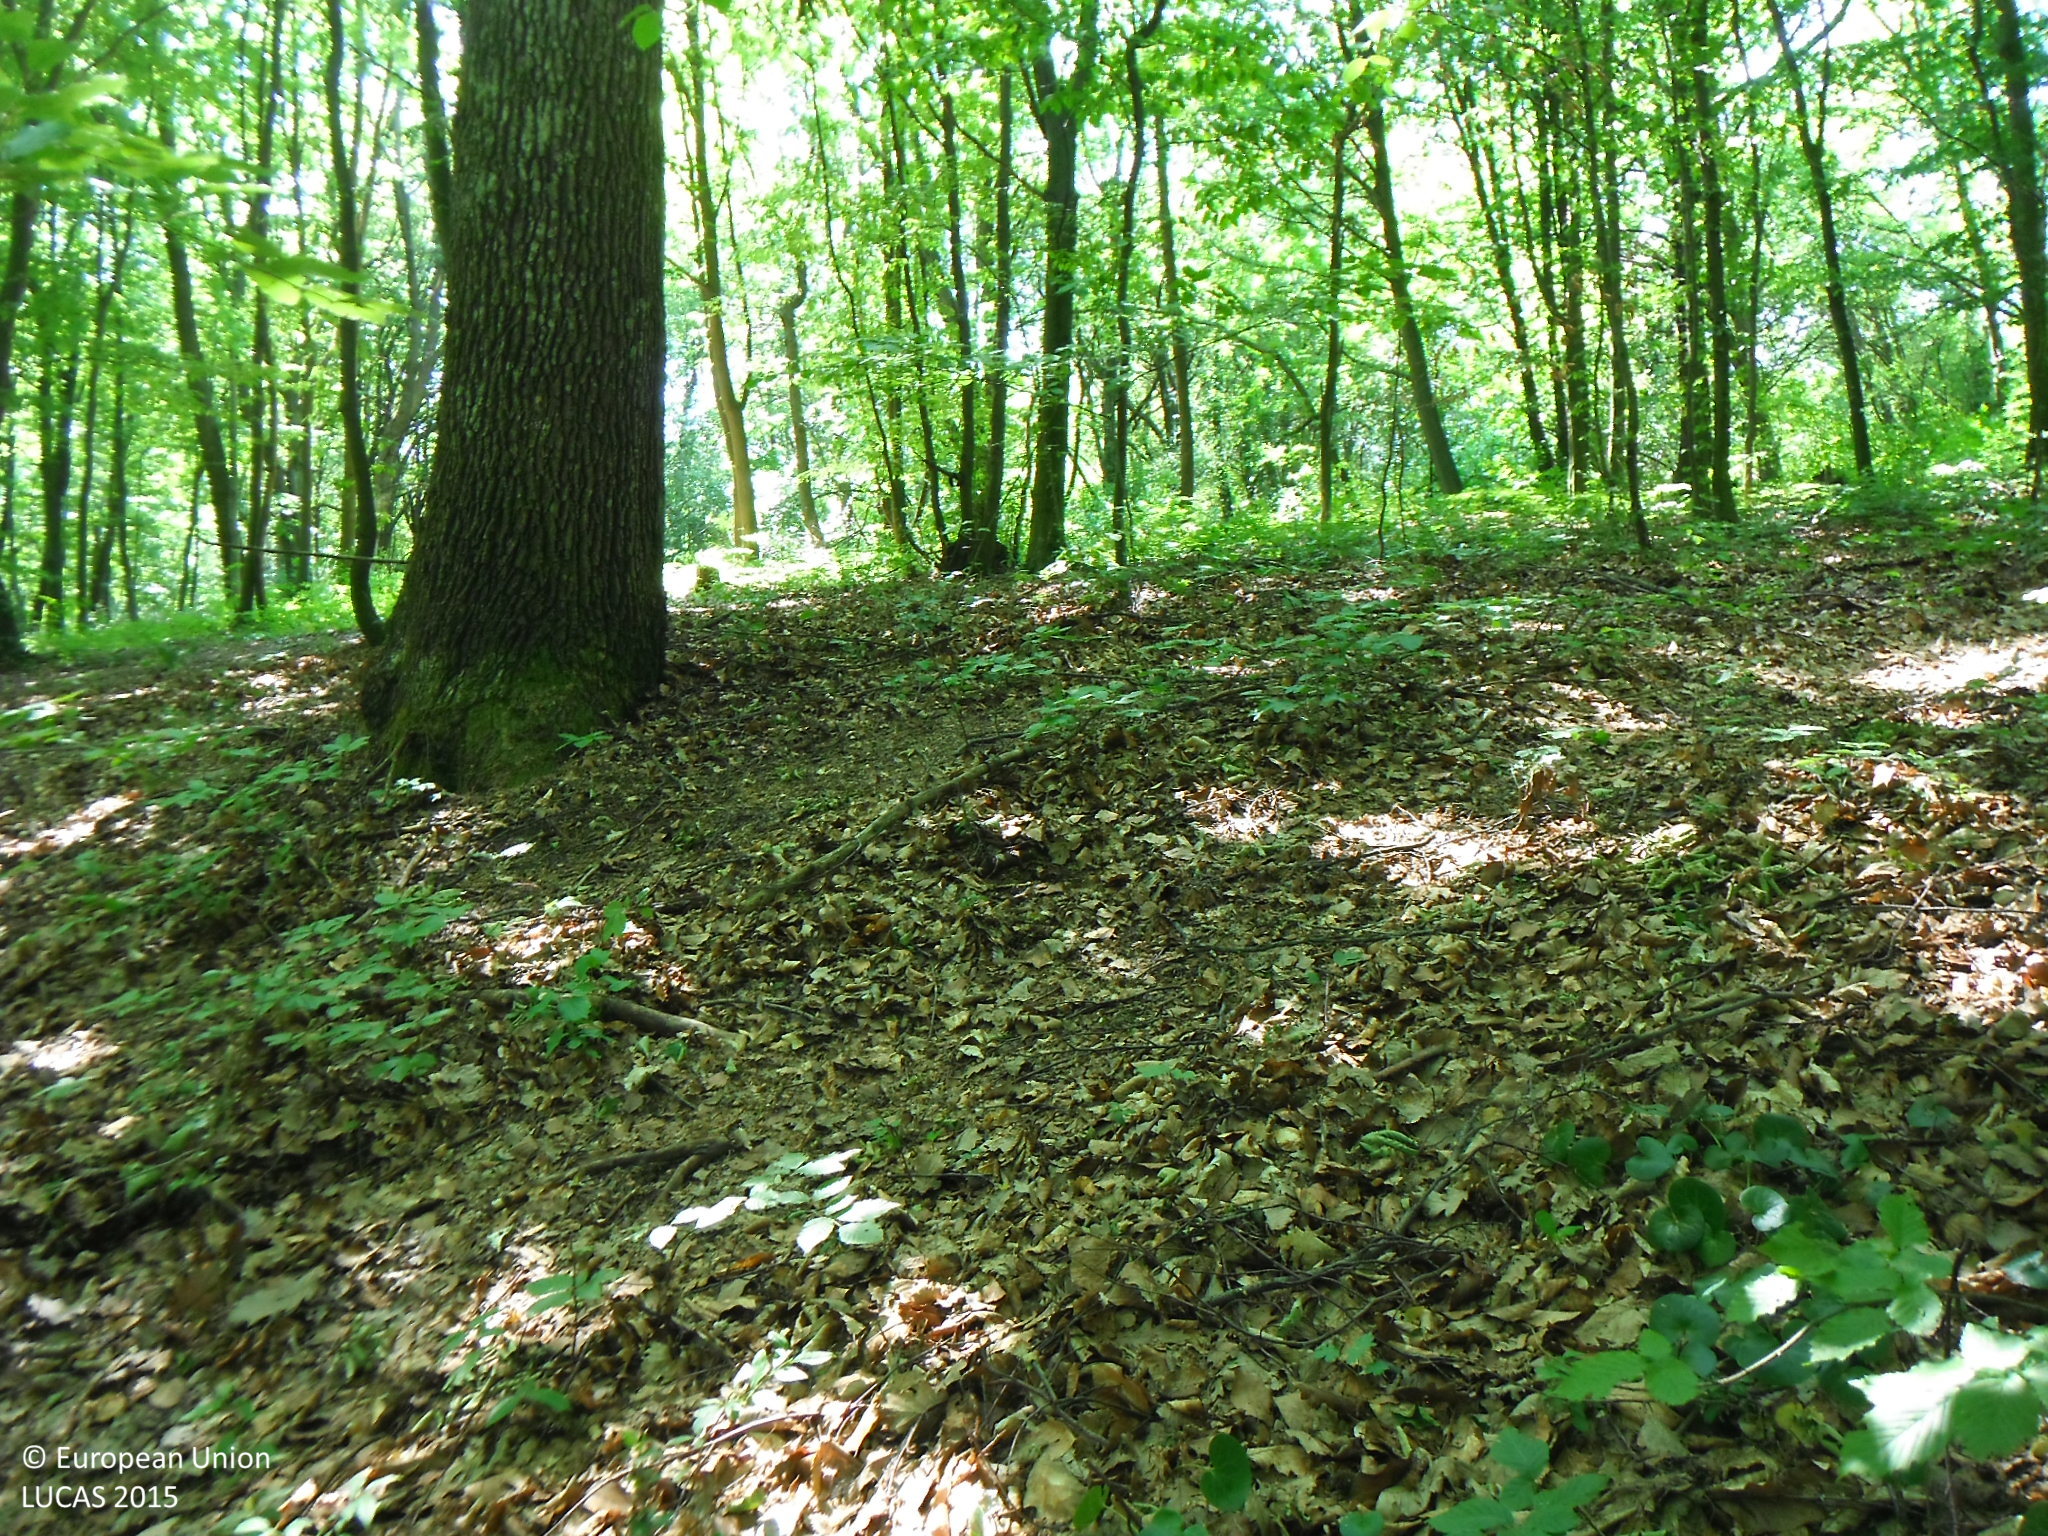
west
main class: Woodland
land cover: Broadleaved woodland
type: beech forest
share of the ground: > 75 %
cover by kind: broadleaved forest trees 95 %, shrubs 5 %
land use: Forestry
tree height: > 5 m
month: June
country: SK
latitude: 48.8674
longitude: 21.9005
